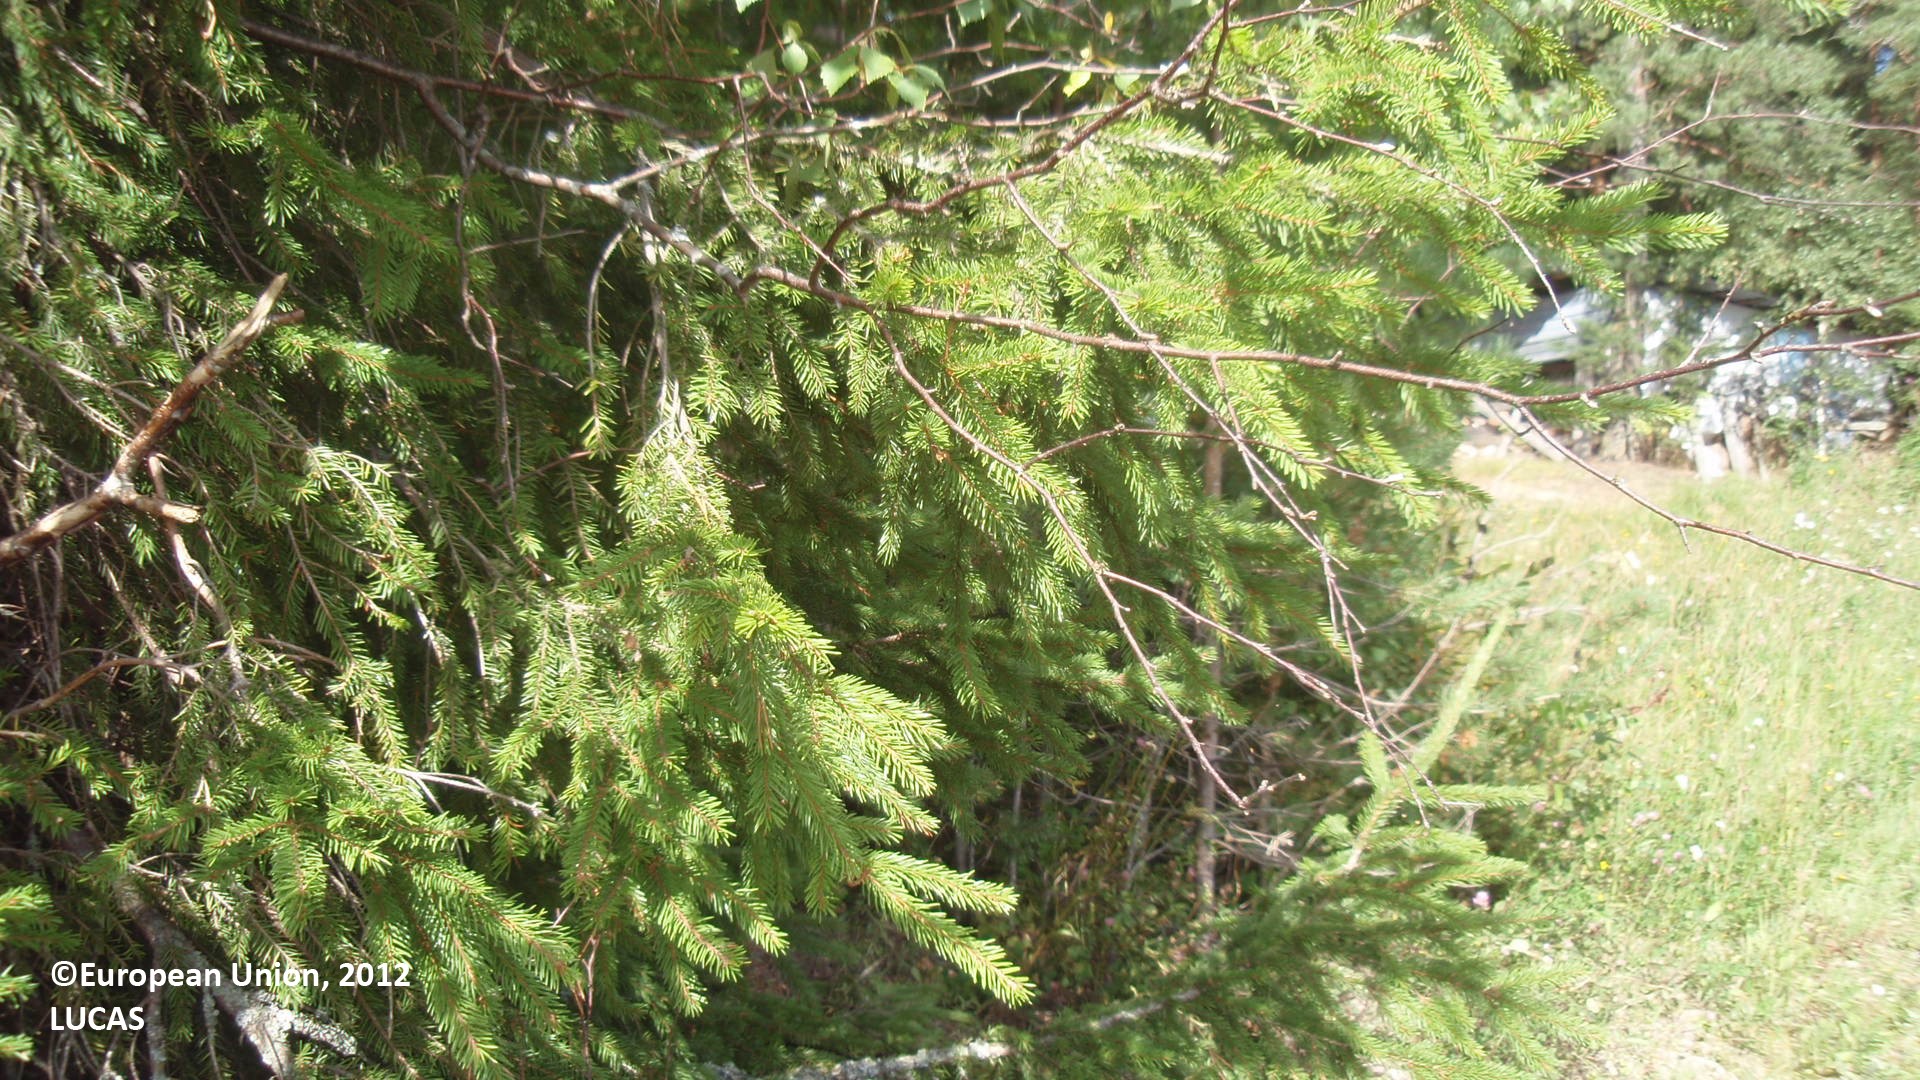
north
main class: Cropland
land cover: Barley
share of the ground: > 75 %
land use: Agriculture (excluding fallow land and kitchen gardens)
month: August
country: FI
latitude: 60.6551
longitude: 27.4334
